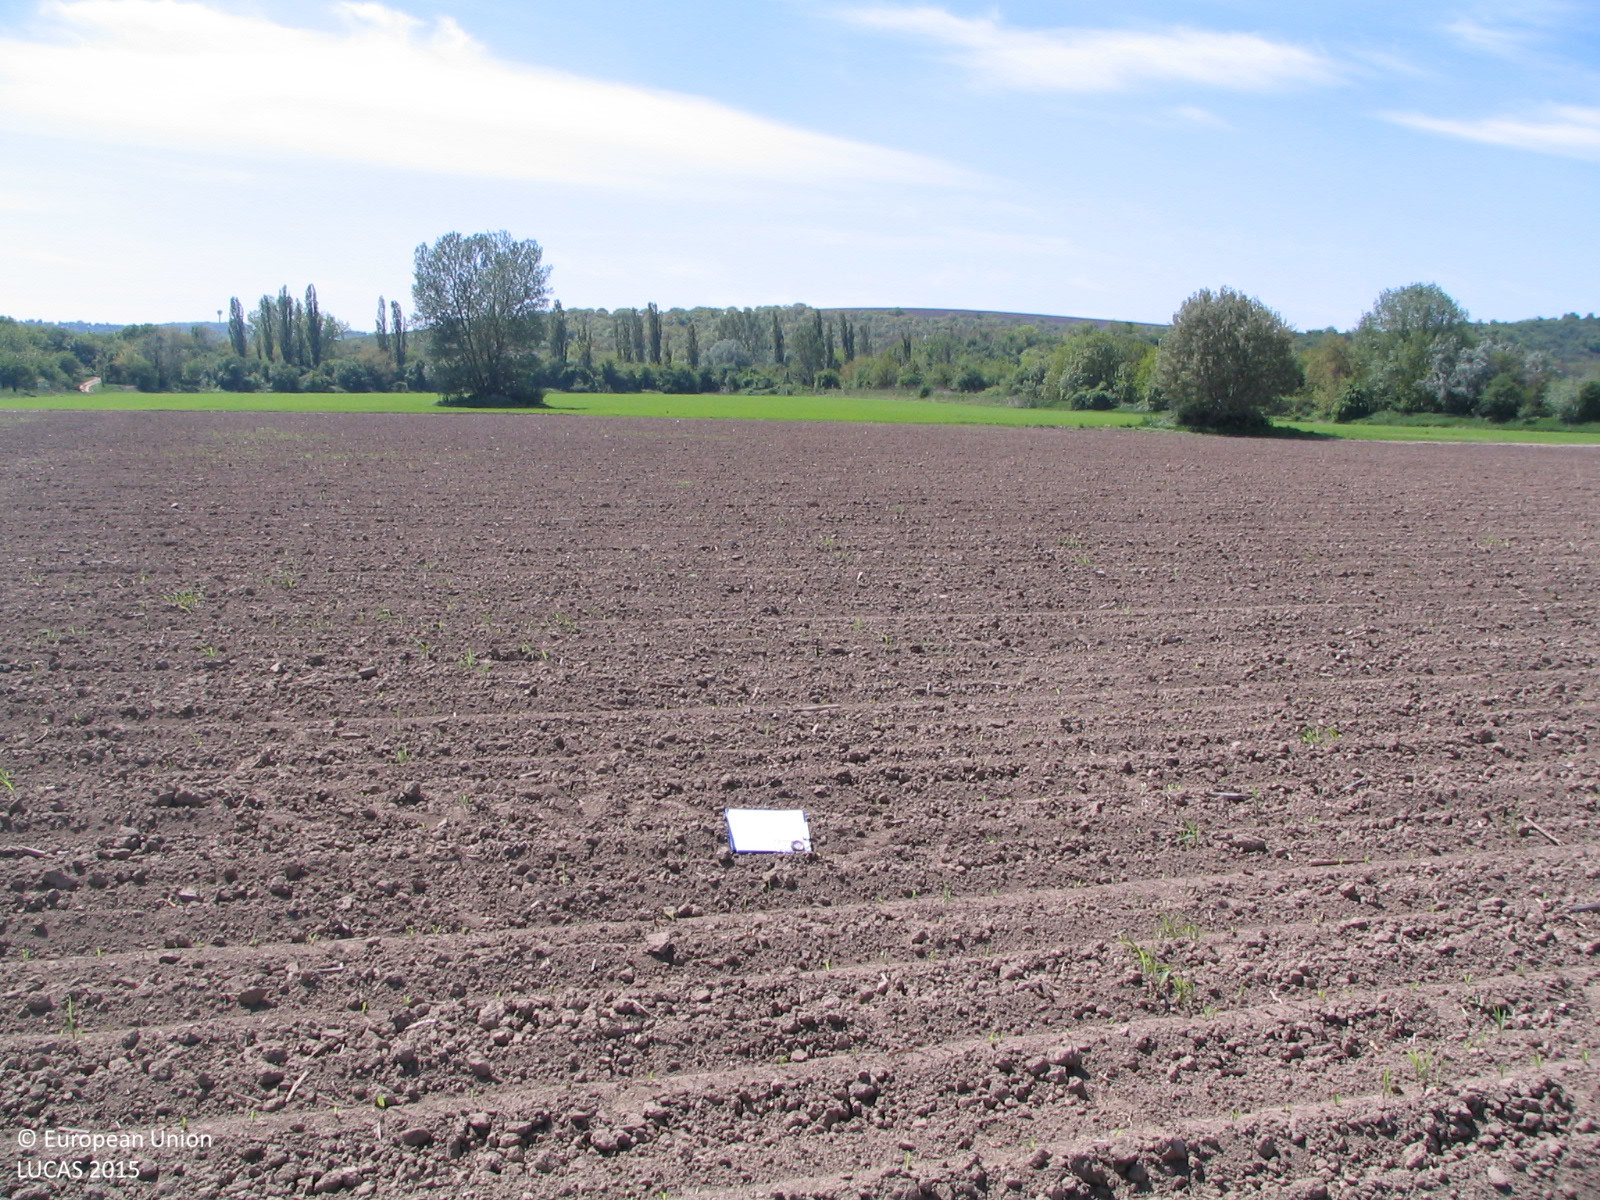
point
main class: Cropland
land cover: Maize
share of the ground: < 10 %
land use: Agriculture (excluding fallow land and kitchen gardens)
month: May
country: BG
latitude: 43.7014
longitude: 24.0401
